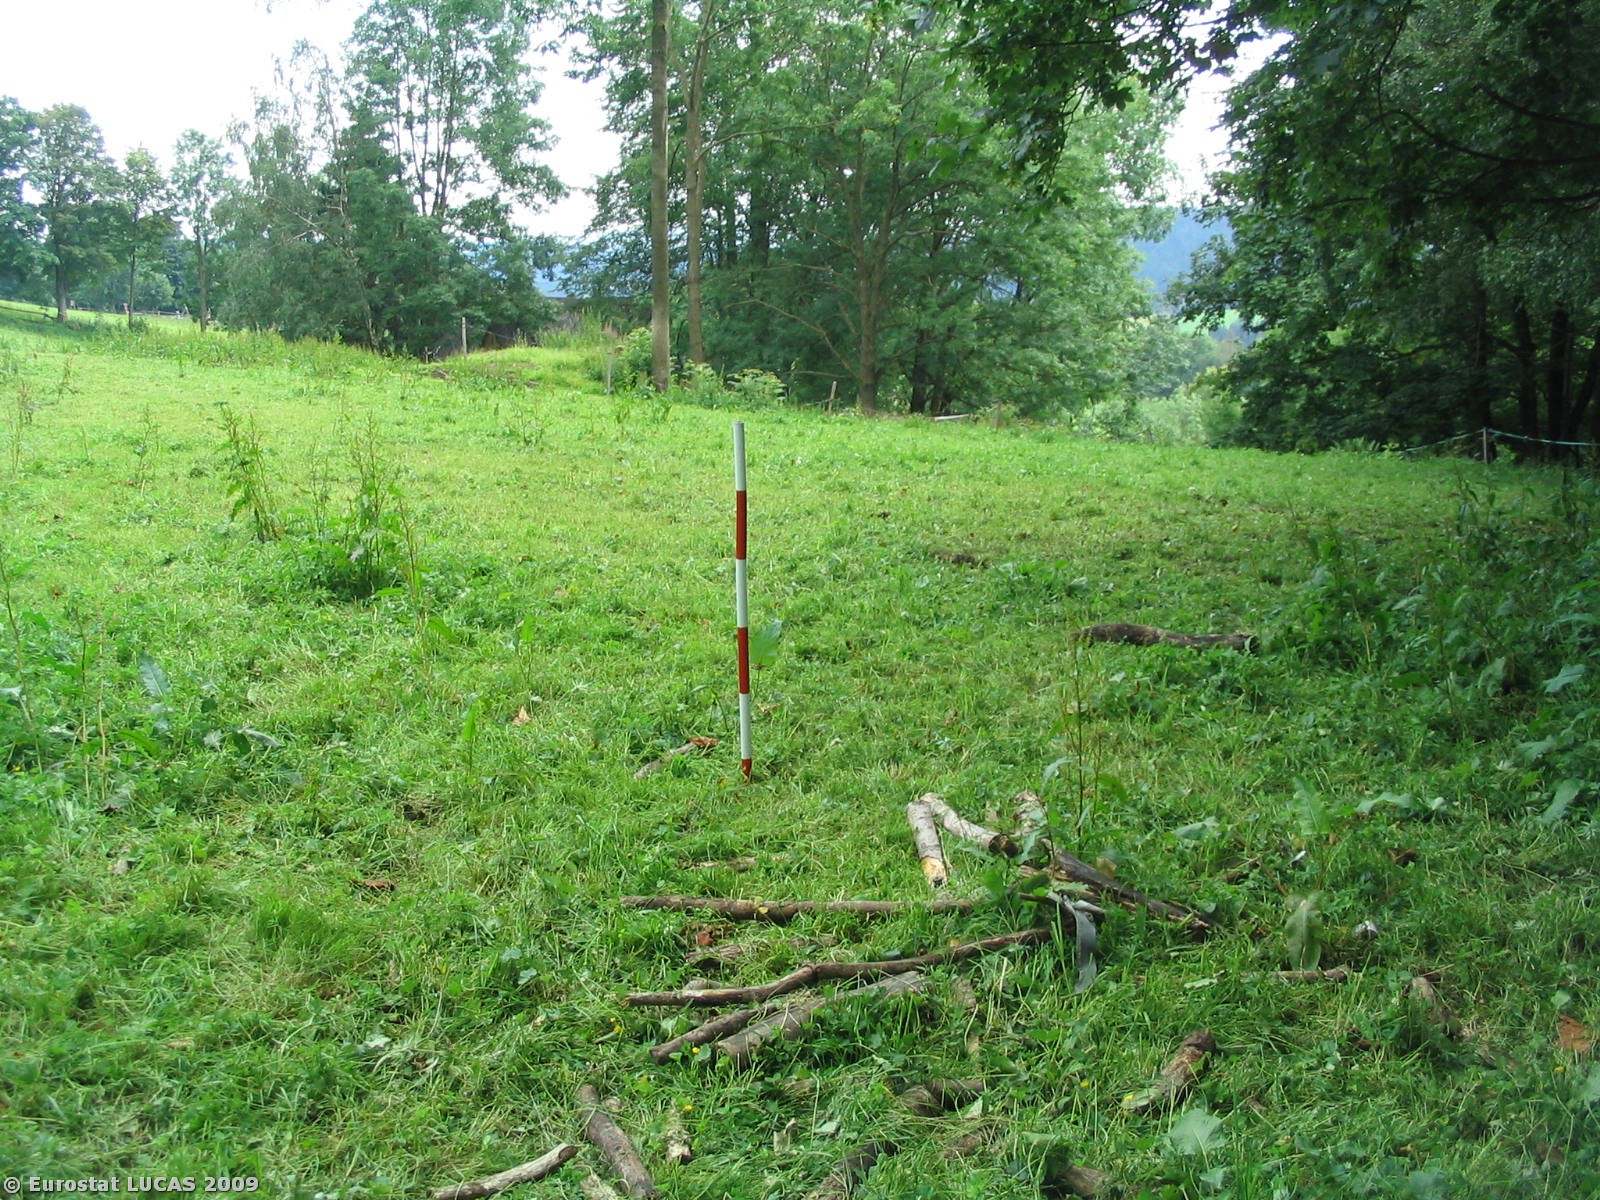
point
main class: Grassland
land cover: Grassland without tree/shrub cover
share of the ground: > 75 %
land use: Agriculture (excluding fallow land and kitchen gardens)
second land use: Nature reserves
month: July
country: CZ
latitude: 50.6984
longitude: 15.5401
